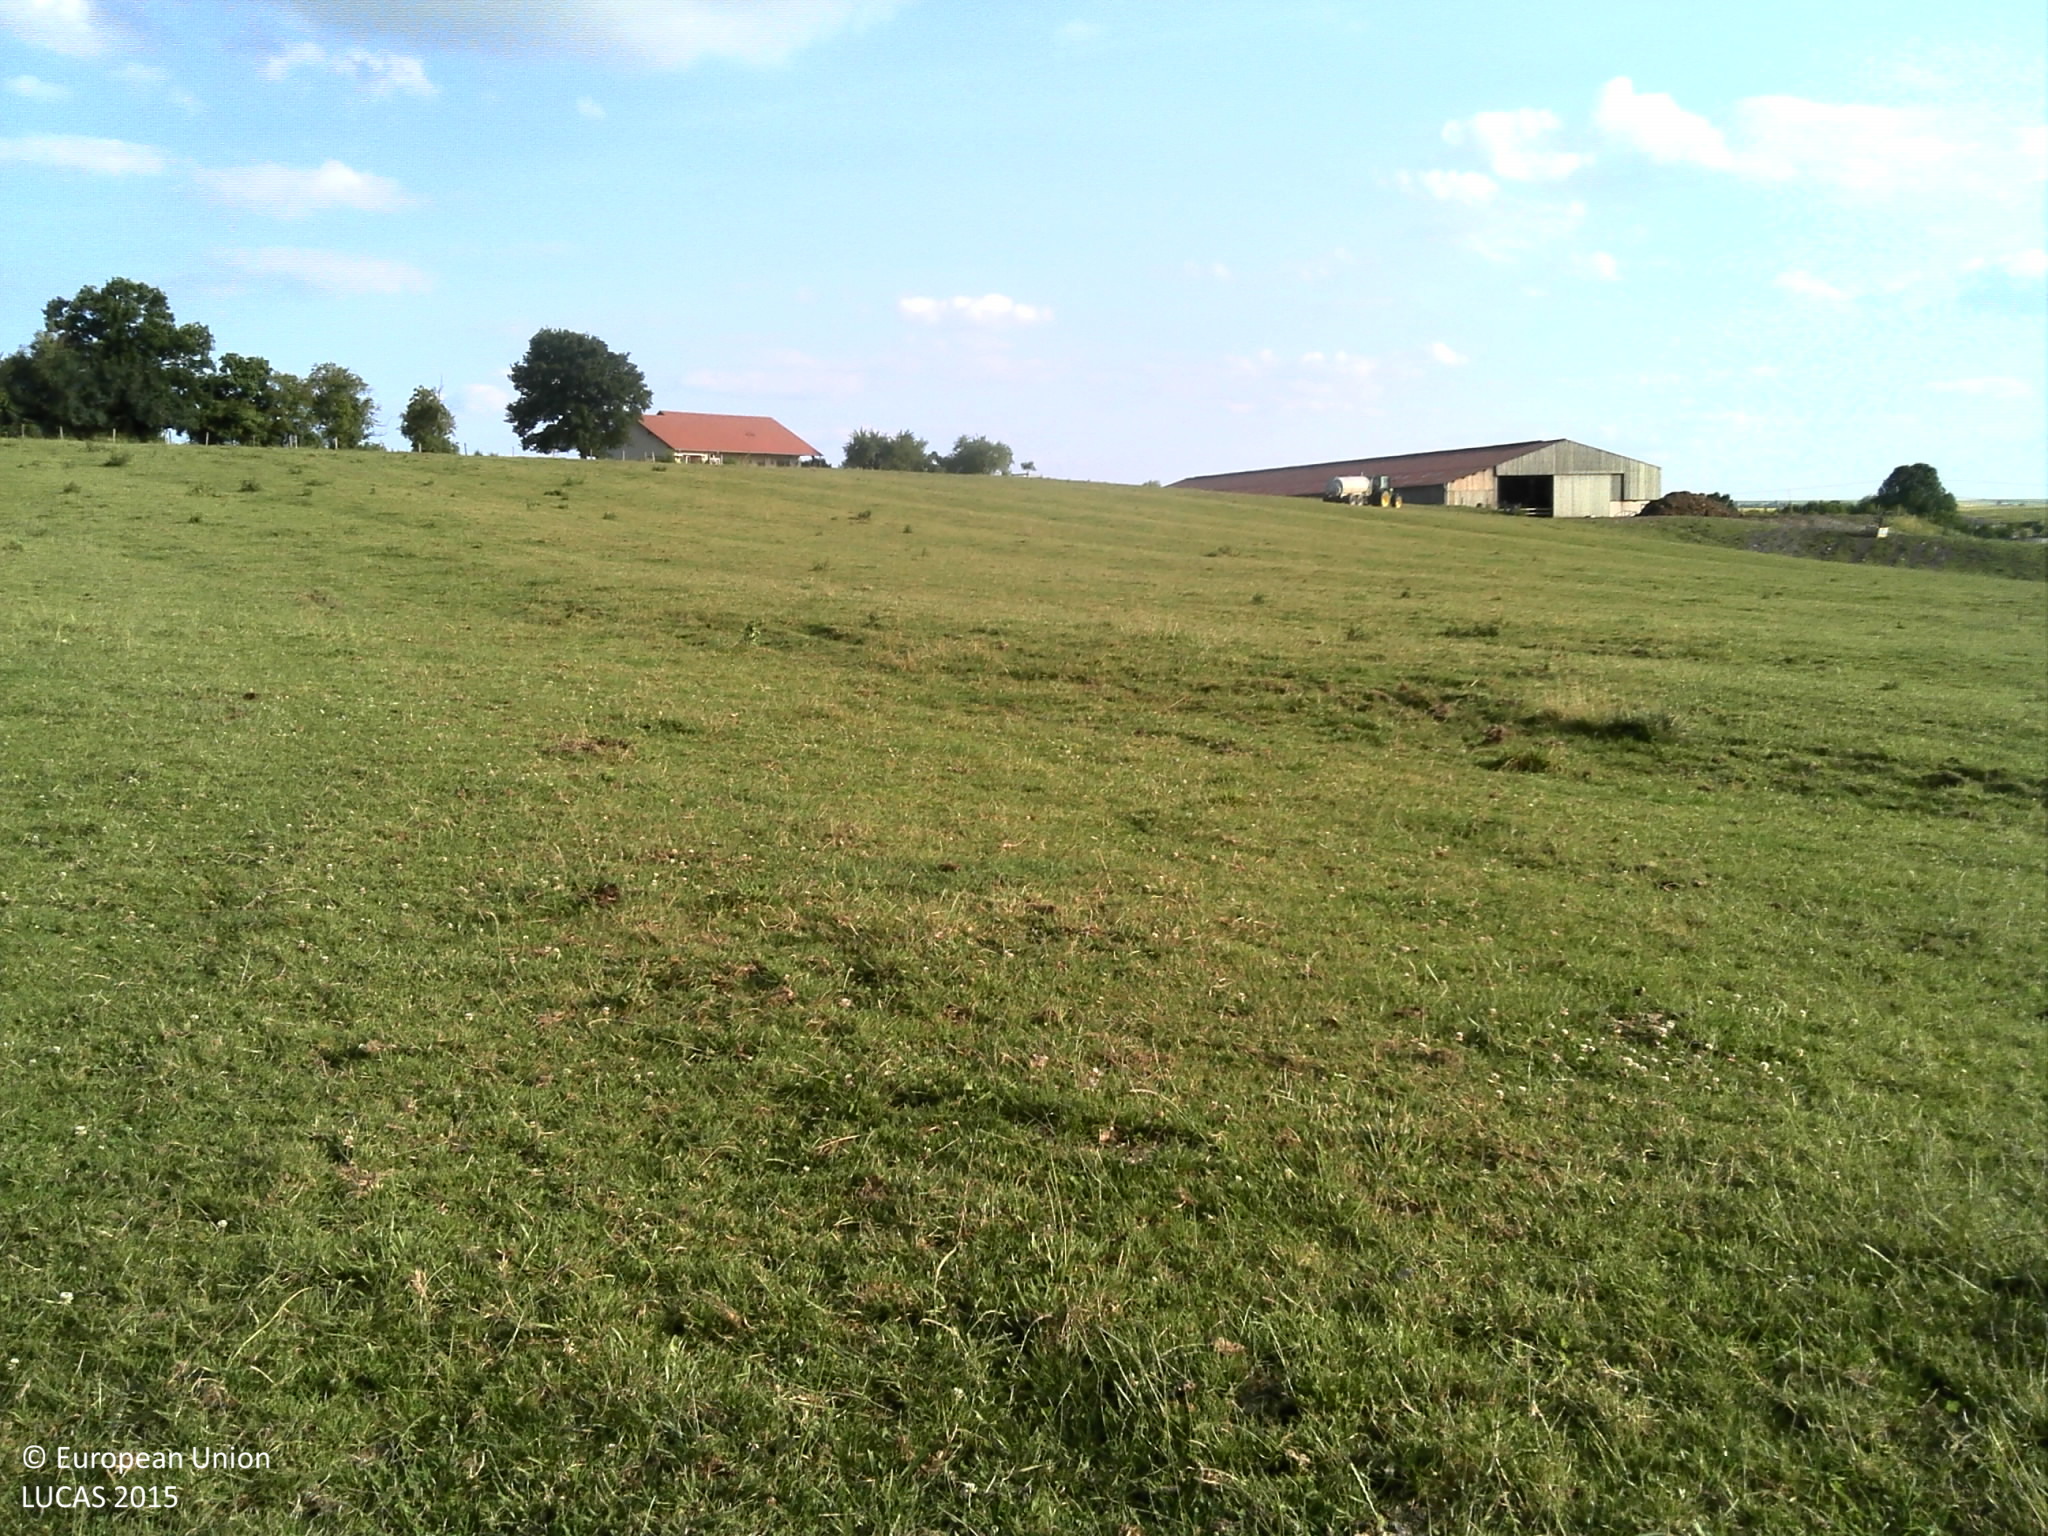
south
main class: Grassland
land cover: Grassland without tree/shrub cover
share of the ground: > 75 %
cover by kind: herbaceous plants 100 %
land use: Agriculture (excluding fallow land and kitchen gardens)
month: June
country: FR
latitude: 49.1577
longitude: 6.4759
